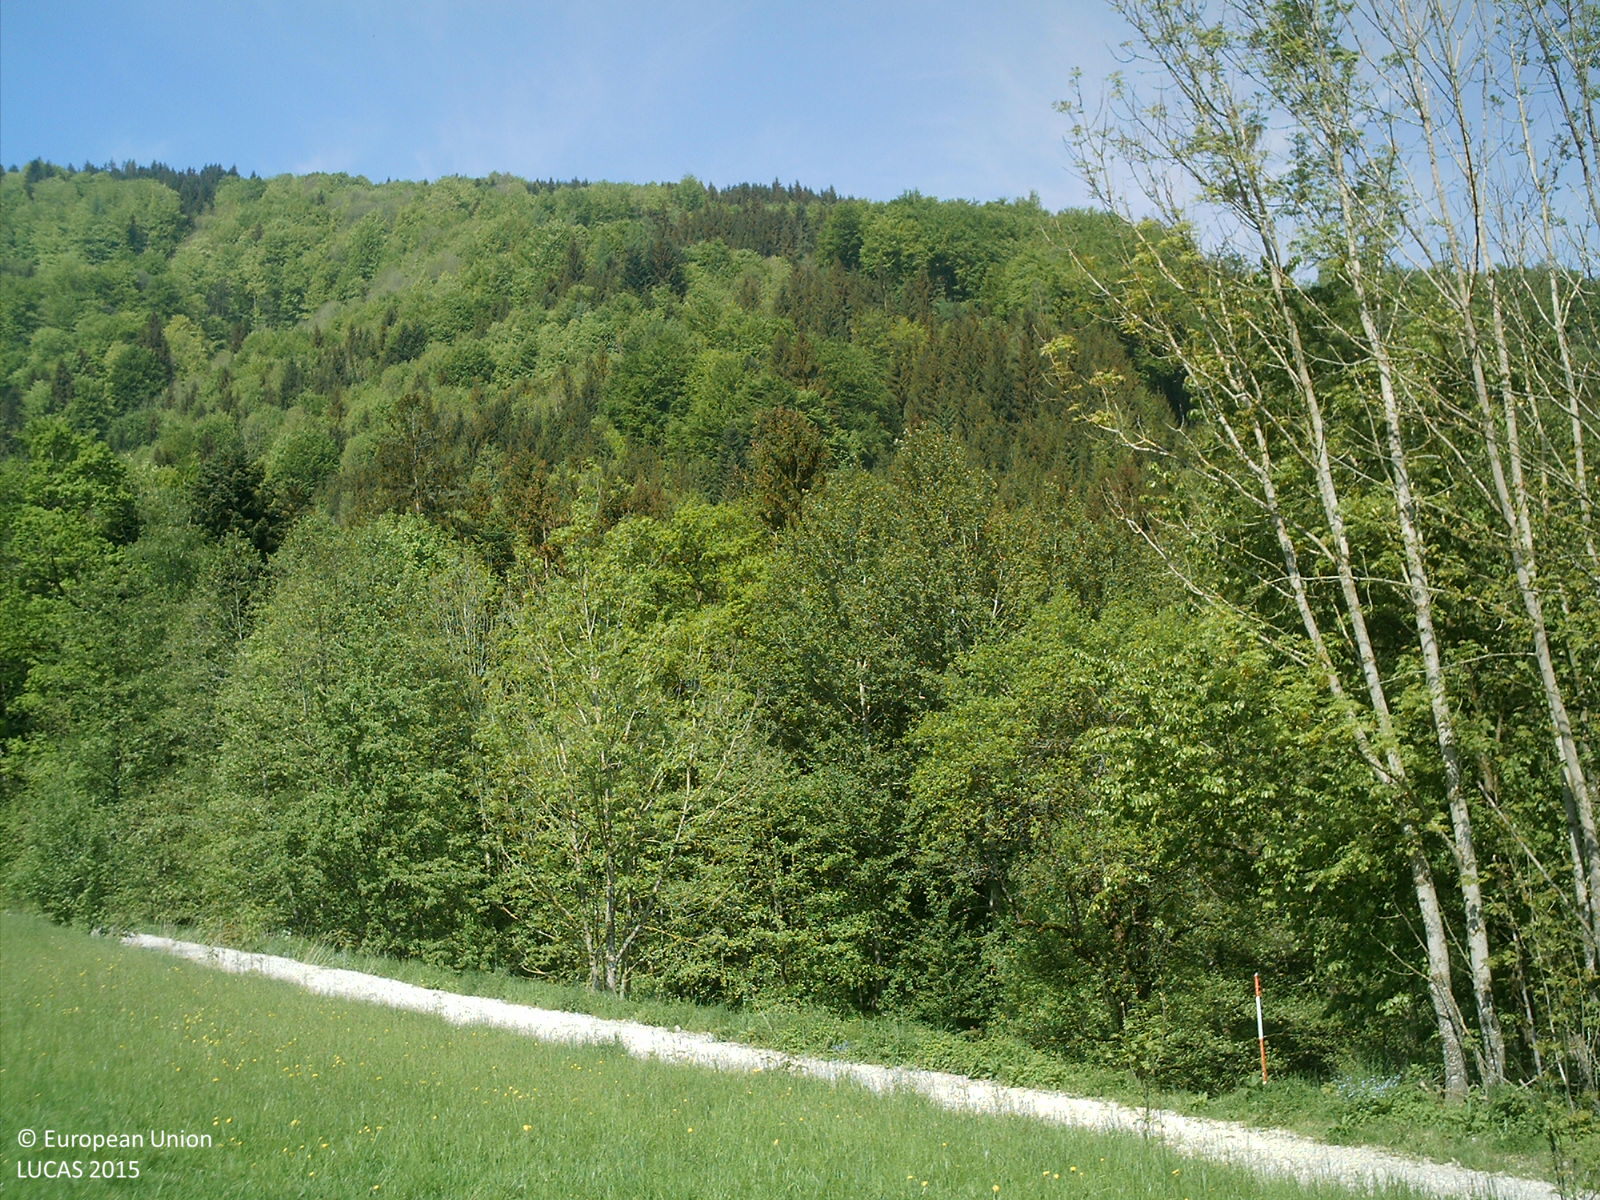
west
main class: Woodland
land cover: Broadleaved woodland
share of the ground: 50 - 75 %
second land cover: Grassland without tree/shrub cover
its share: > 75 %
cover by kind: broadleaved forest trees 50 %, shrubs 50 %
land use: Residential
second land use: Agriculture (excluding fallow land and kitchen gardens)
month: May
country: AT
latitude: 47.9138
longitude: 14.0804
